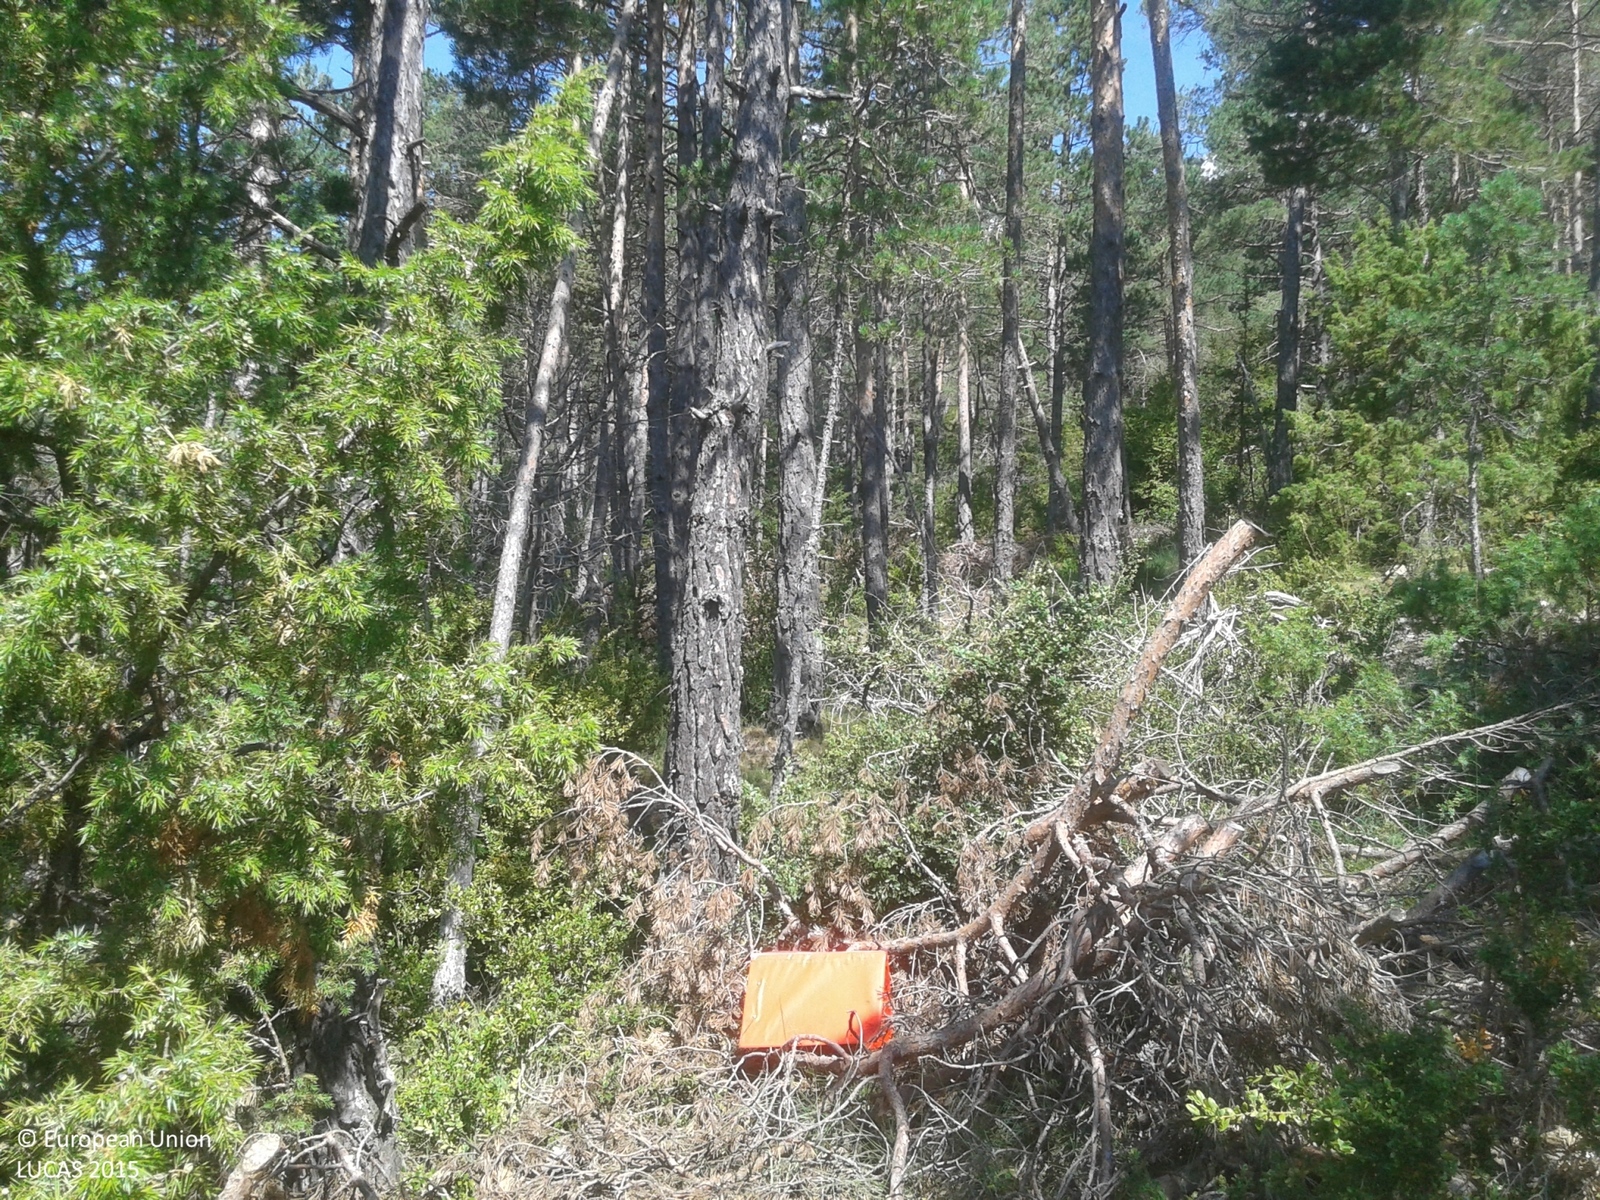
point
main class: Woodland
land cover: Pine dominated coniferous woodland
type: alpine coniferous forest
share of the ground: > 75 %
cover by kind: coniferous forest trees 60 %, shrubs 20 %, herbaceous plants 20 %
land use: Forestry
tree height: > 5 m
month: July
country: ES
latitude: 42.1614
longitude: 1.6241
